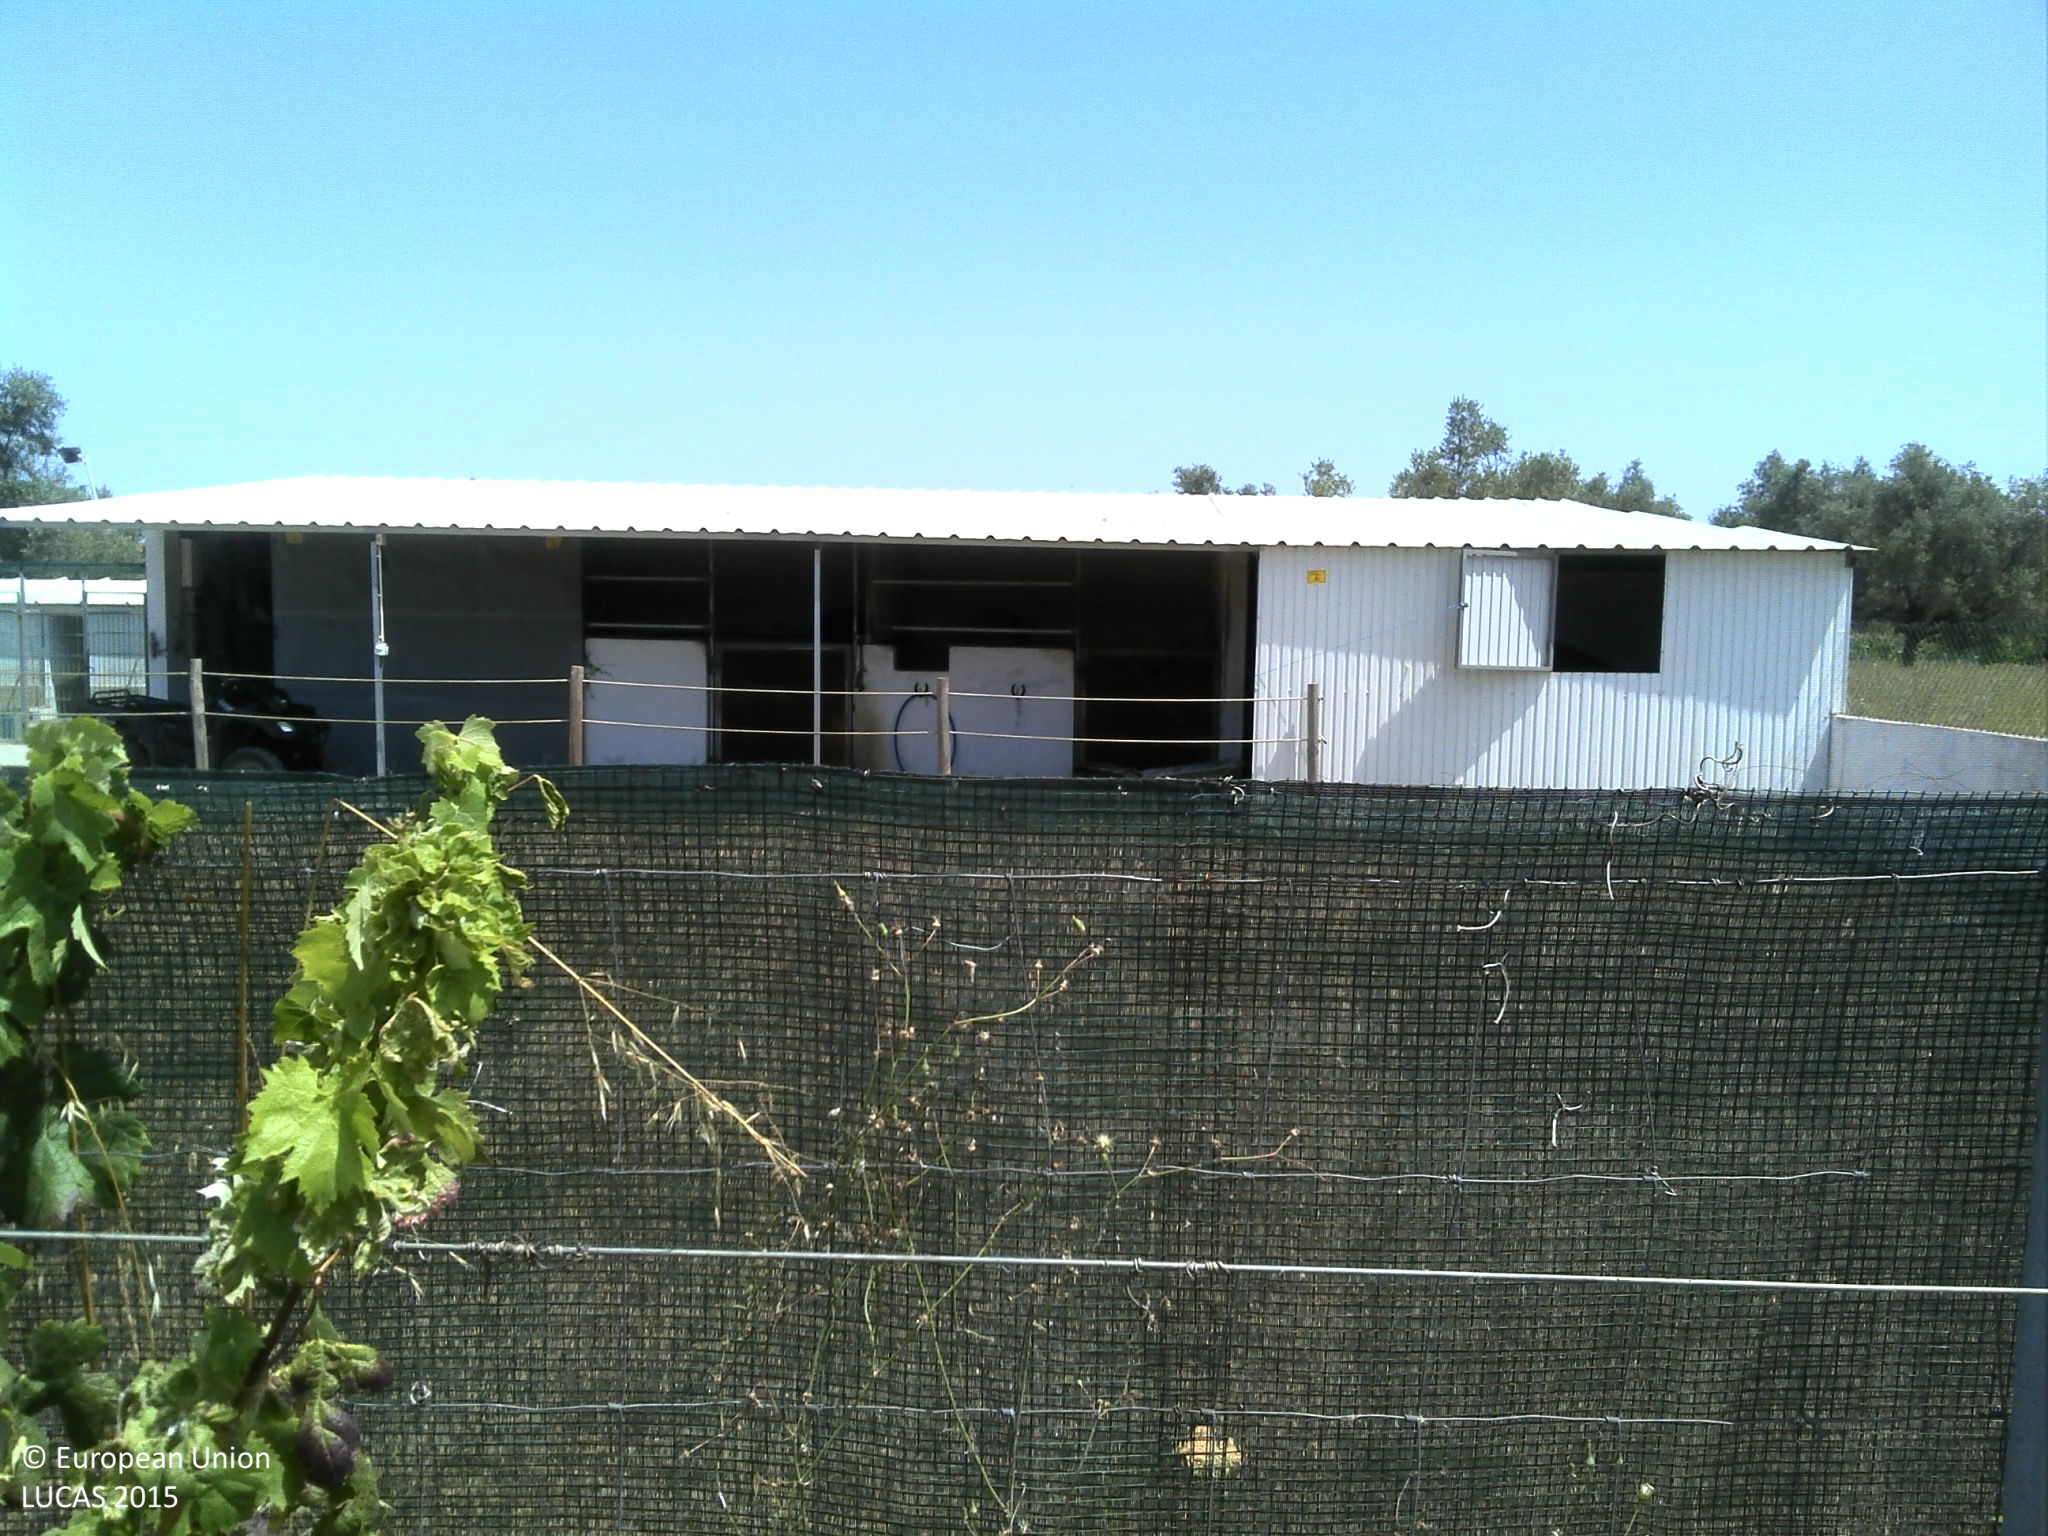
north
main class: Cropland
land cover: Other fresh vegetables
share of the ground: < 10 %
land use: Agriculture (excluding fallow land and kitchen gardens)
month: July
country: PT
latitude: 40.1765
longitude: -8.5835
